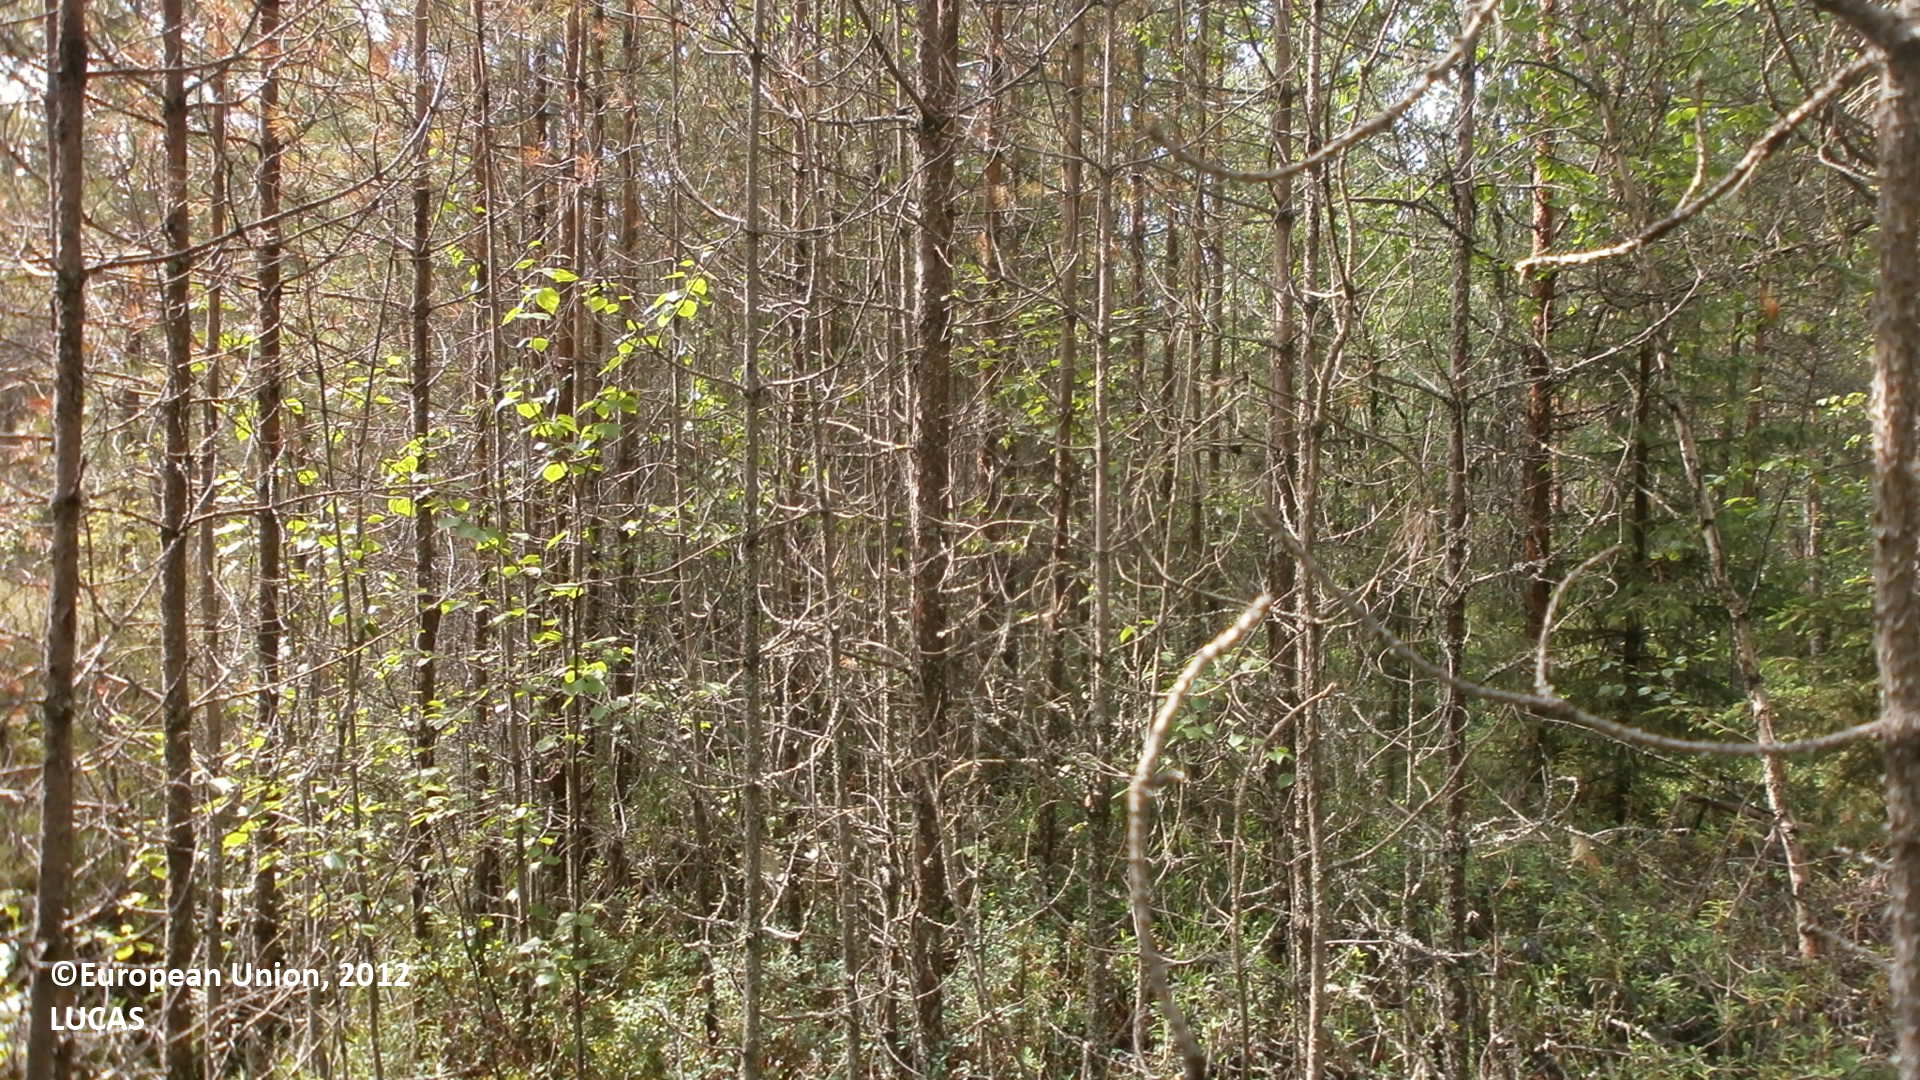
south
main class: Woodland
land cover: Pine dominated coniferous woodland
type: boreal forest
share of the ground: 50 - 75 %
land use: Forestry
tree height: > 5 m
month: July
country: FI
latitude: 64.5657
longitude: 24.4033
